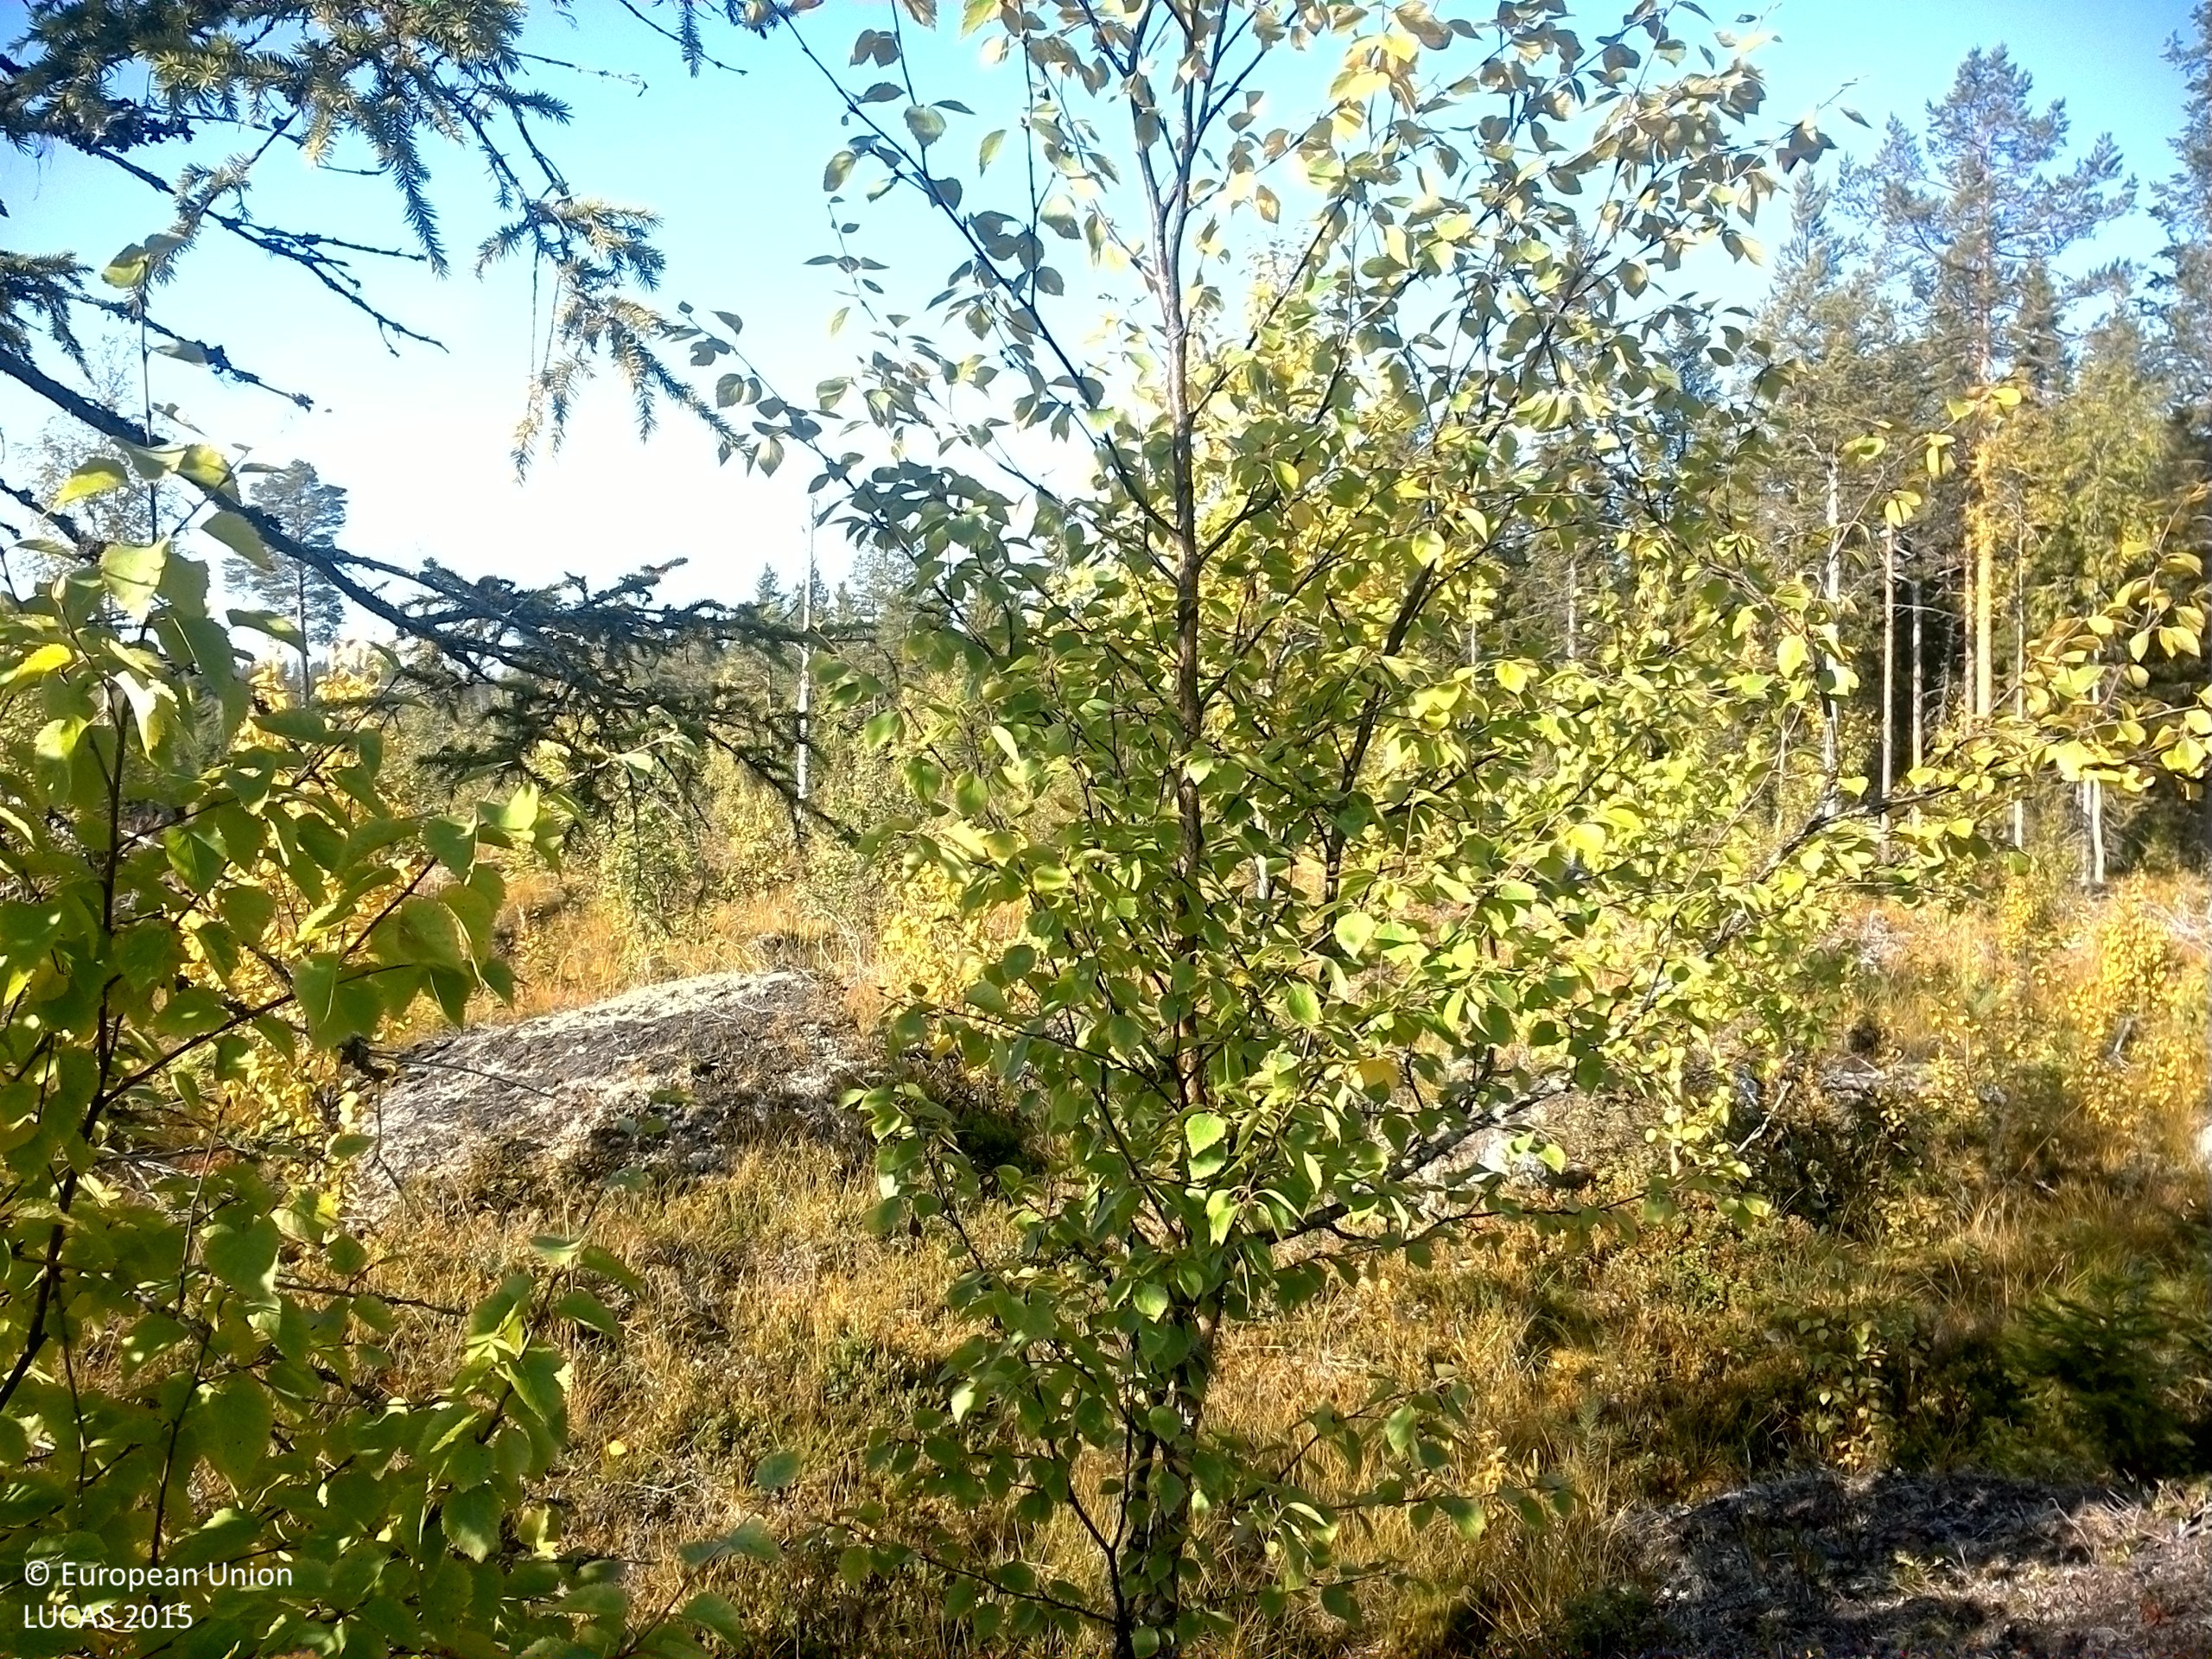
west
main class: Woodland
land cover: Broadleaved woodland
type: boreal forest
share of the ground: 25 - 50 %
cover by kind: broadleaved forest trees 35 %, herbaceous plants 35 %, coniferous forest trees 10 %, shrubs 10 %, lichens and mosses 5 %, unconsolidated bare surface 5 %
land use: Forestry
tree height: < 5 m
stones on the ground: < 10 %
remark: Clear cut
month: September
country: SE
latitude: 64.0636
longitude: 16.5485
